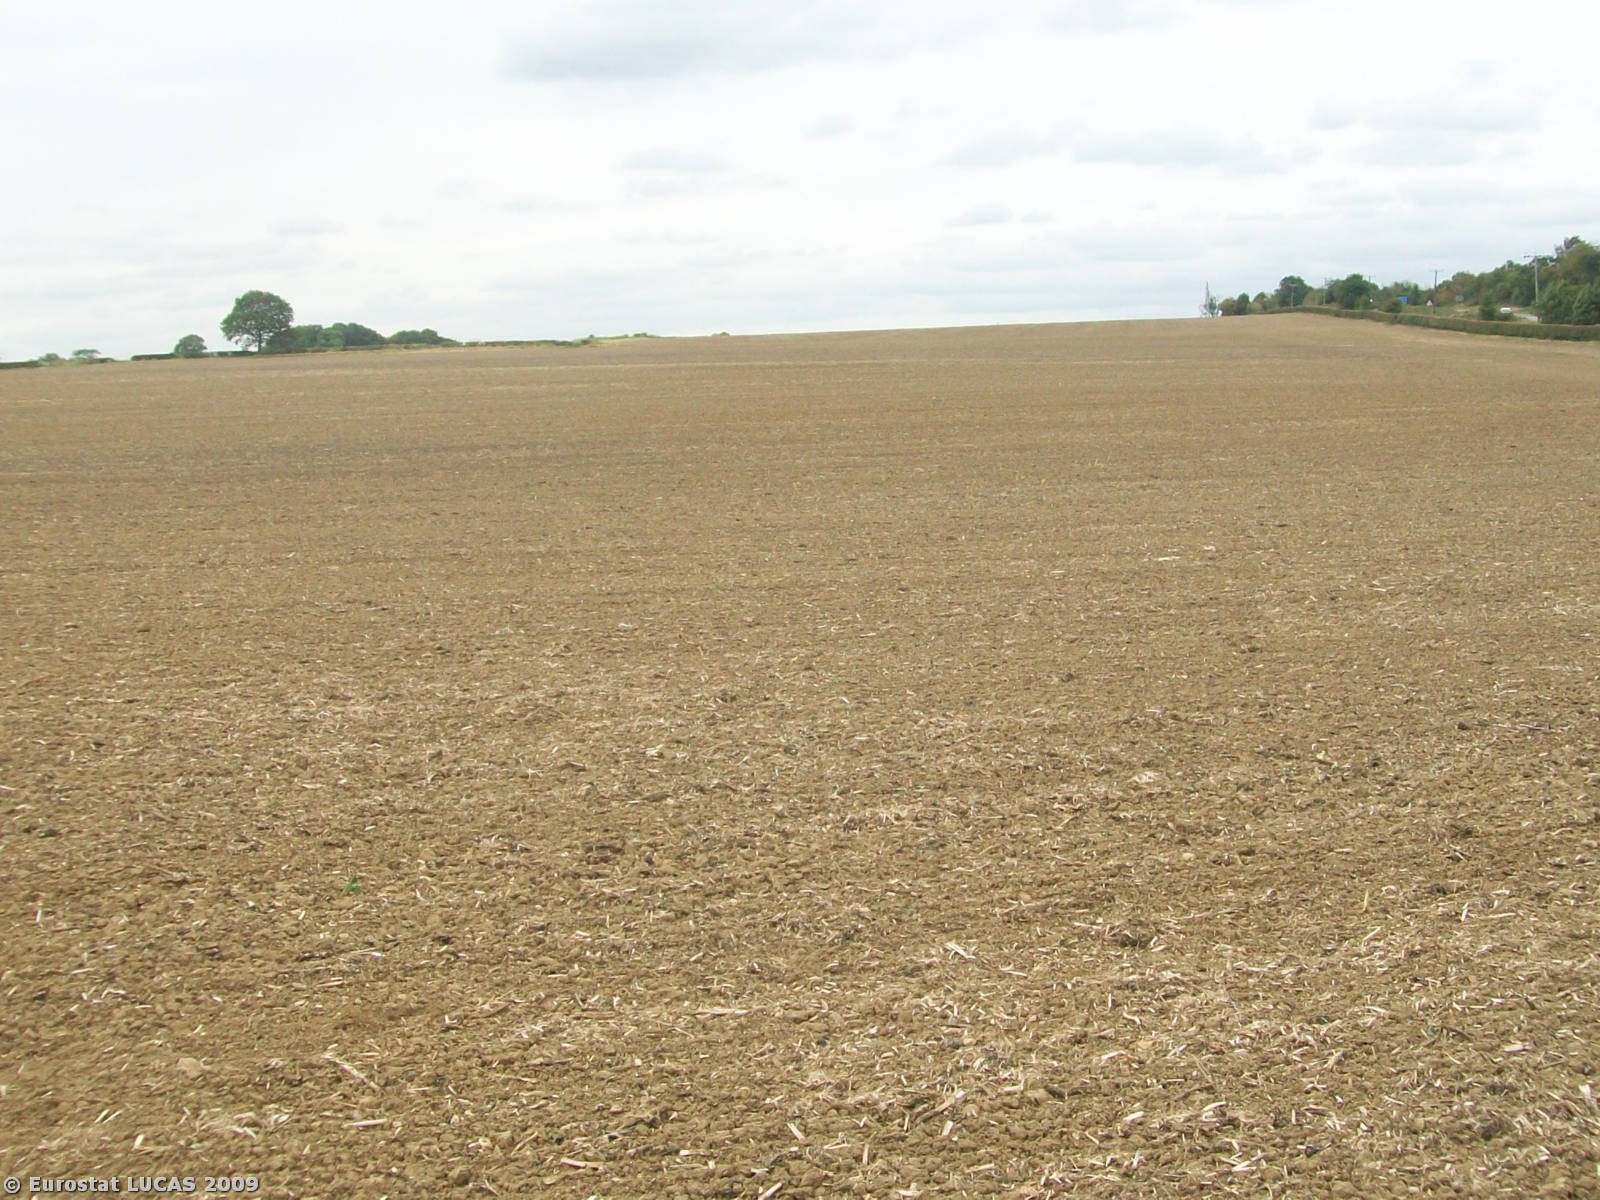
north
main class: Cropland
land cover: Common wheat
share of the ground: < 10 %
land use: Agriculture (excluding fallow land and kitchen gardens)
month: September
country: GB
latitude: 52.4734
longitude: -1.2807
